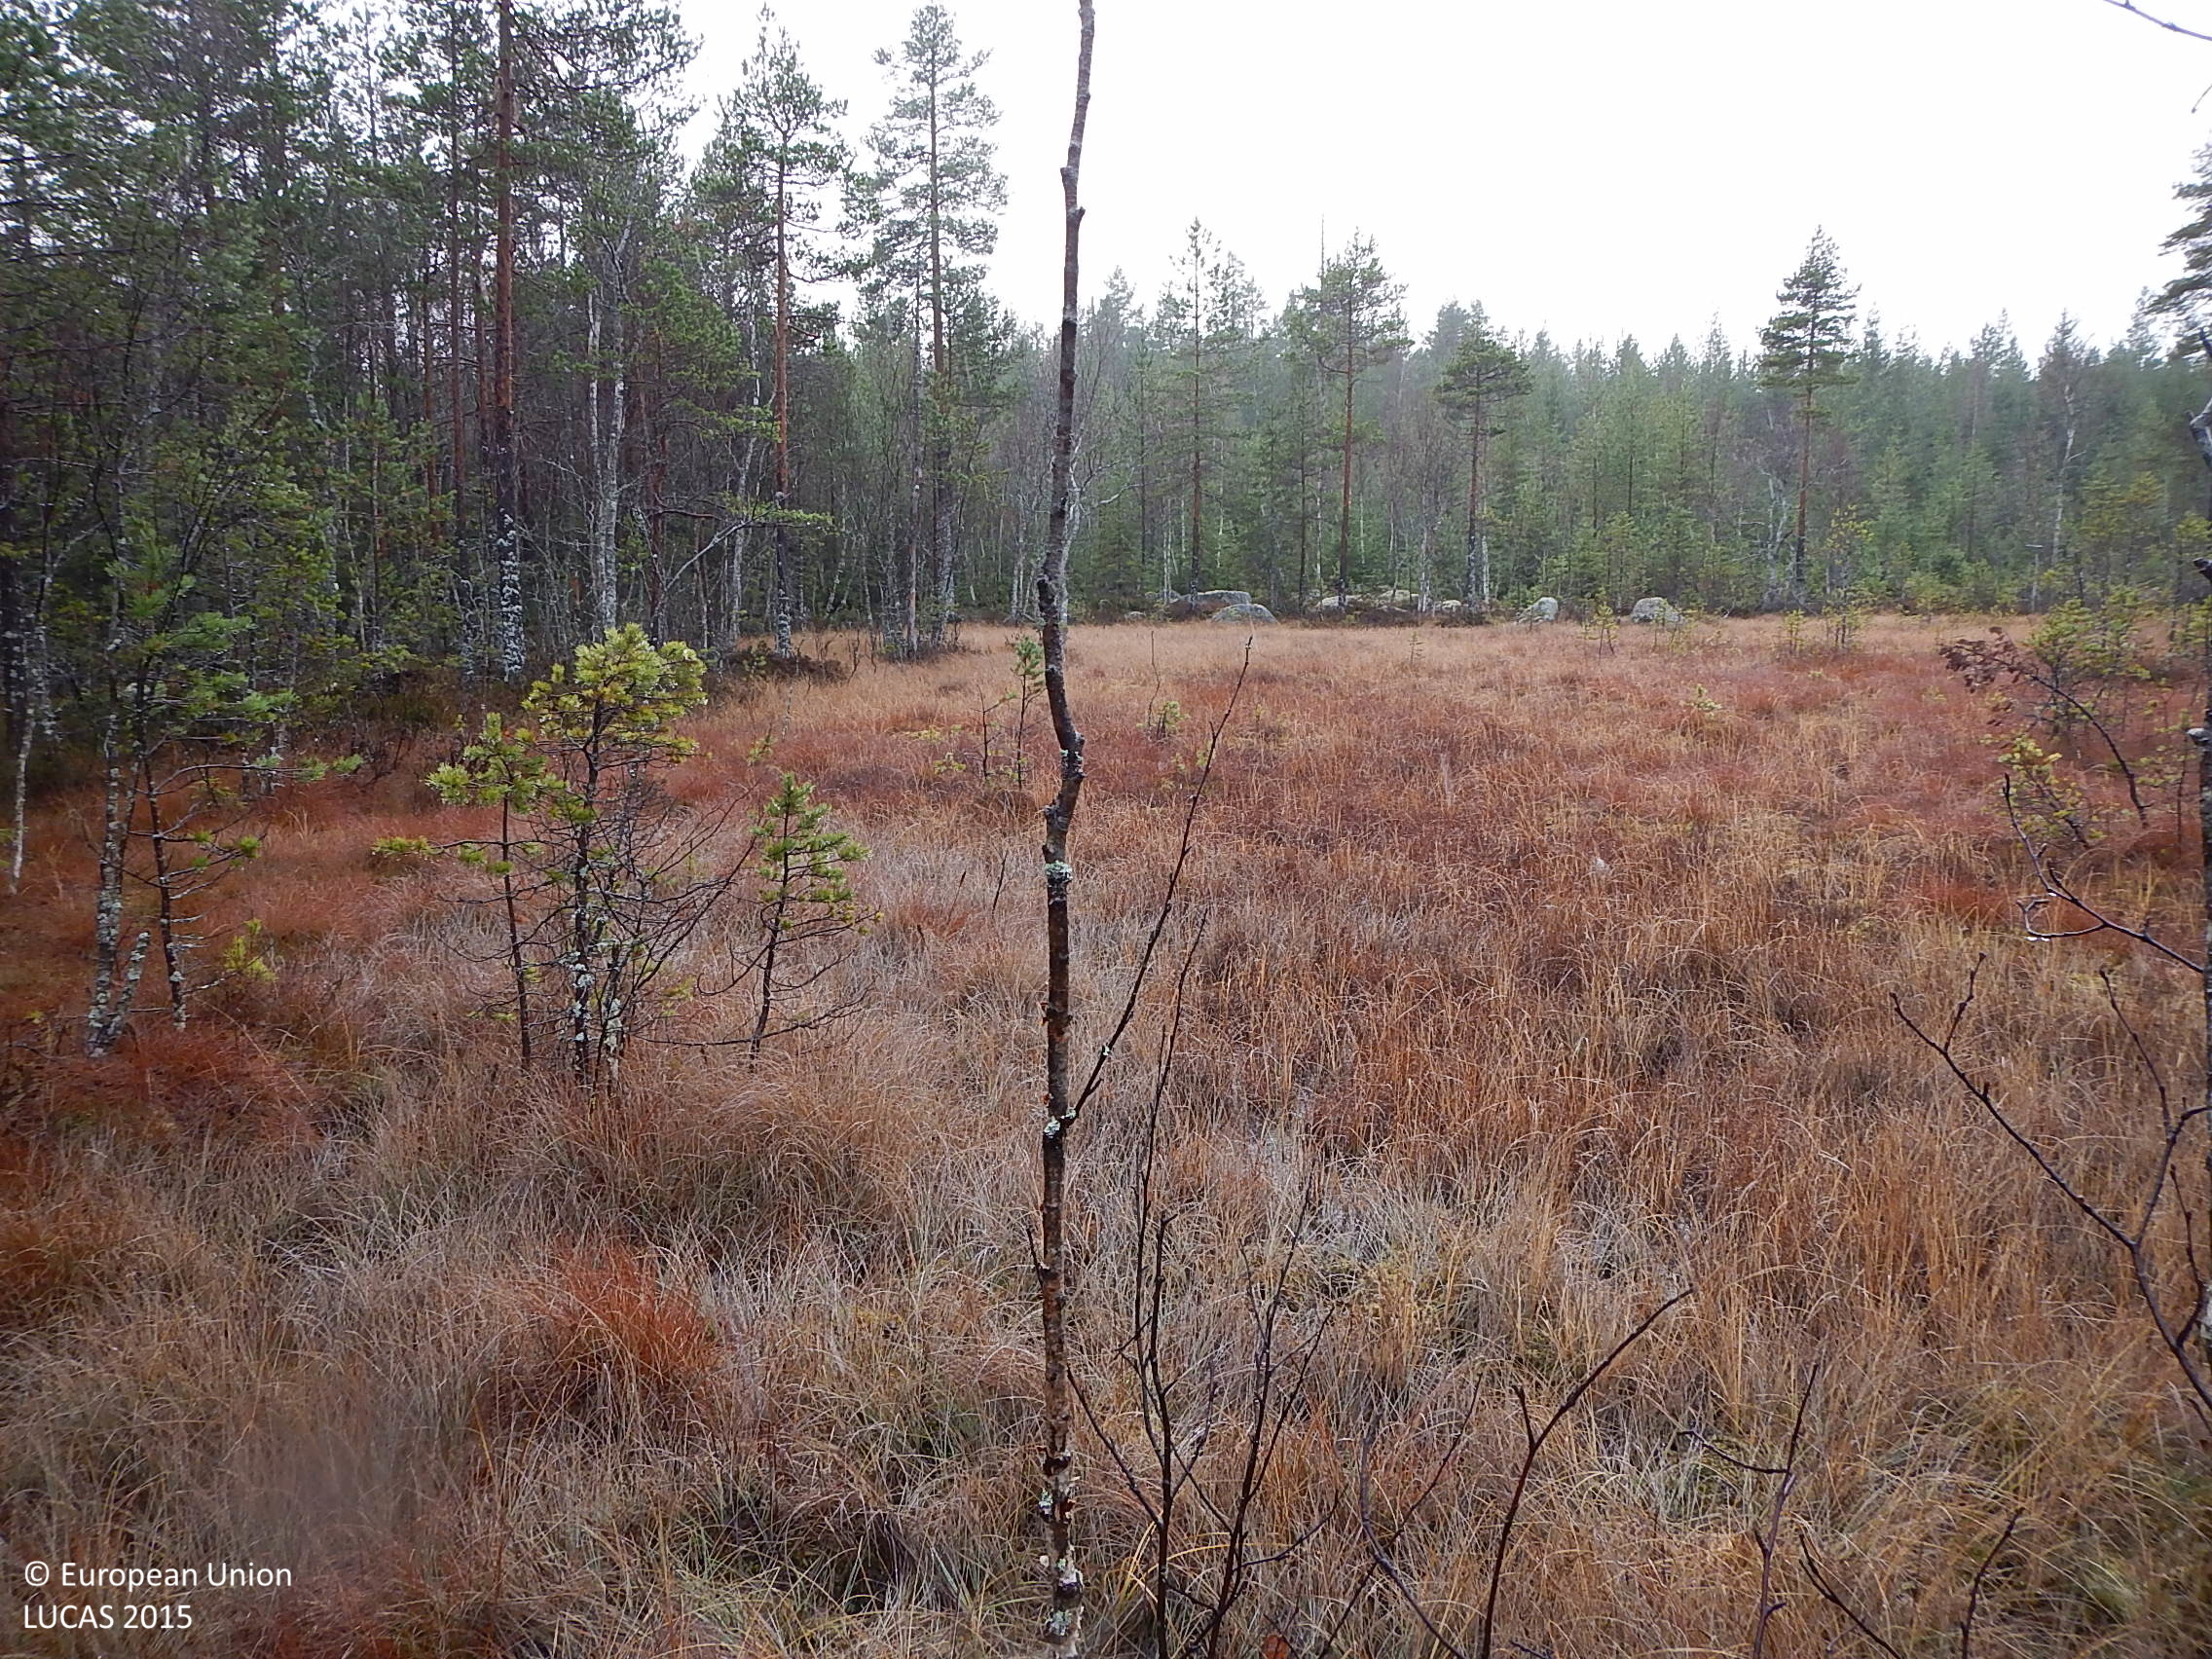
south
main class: Woodland
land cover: Pine dominated mixed woodland
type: mire and swamp forests
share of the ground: 50 - 75 %
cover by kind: coniferous forest trees 30 %, herbaceous plants 30 %, broadleaved forest trees 20 %, lichens and mosses 20 %
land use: Forestry
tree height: > 5 m
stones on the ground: < 10 %
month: November
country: SE
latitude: 61.4350
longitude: 17.0155
